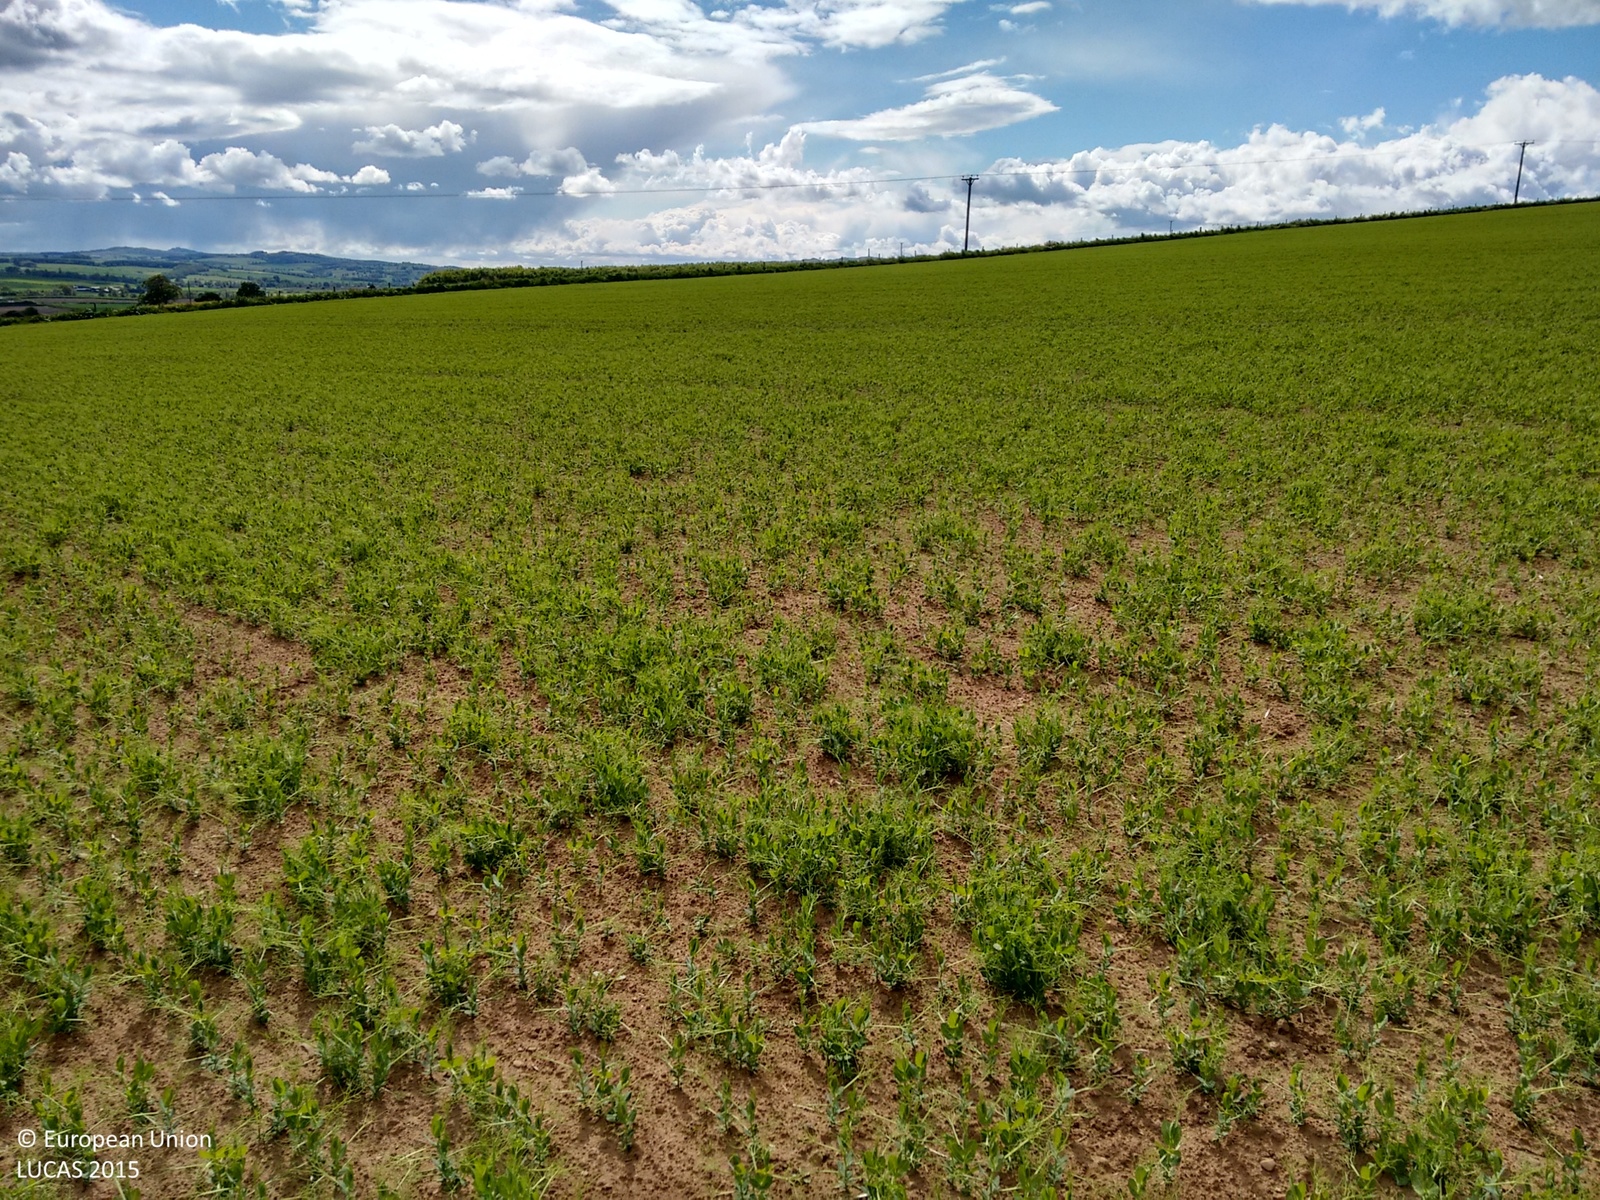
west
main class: Cropland
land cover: Dry pulses
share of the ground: 25 - 50 %
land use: Agriculture (excluding fallow land and kitchen gardens)
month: May
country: GB
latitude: 55.5433
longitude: -2.4372
